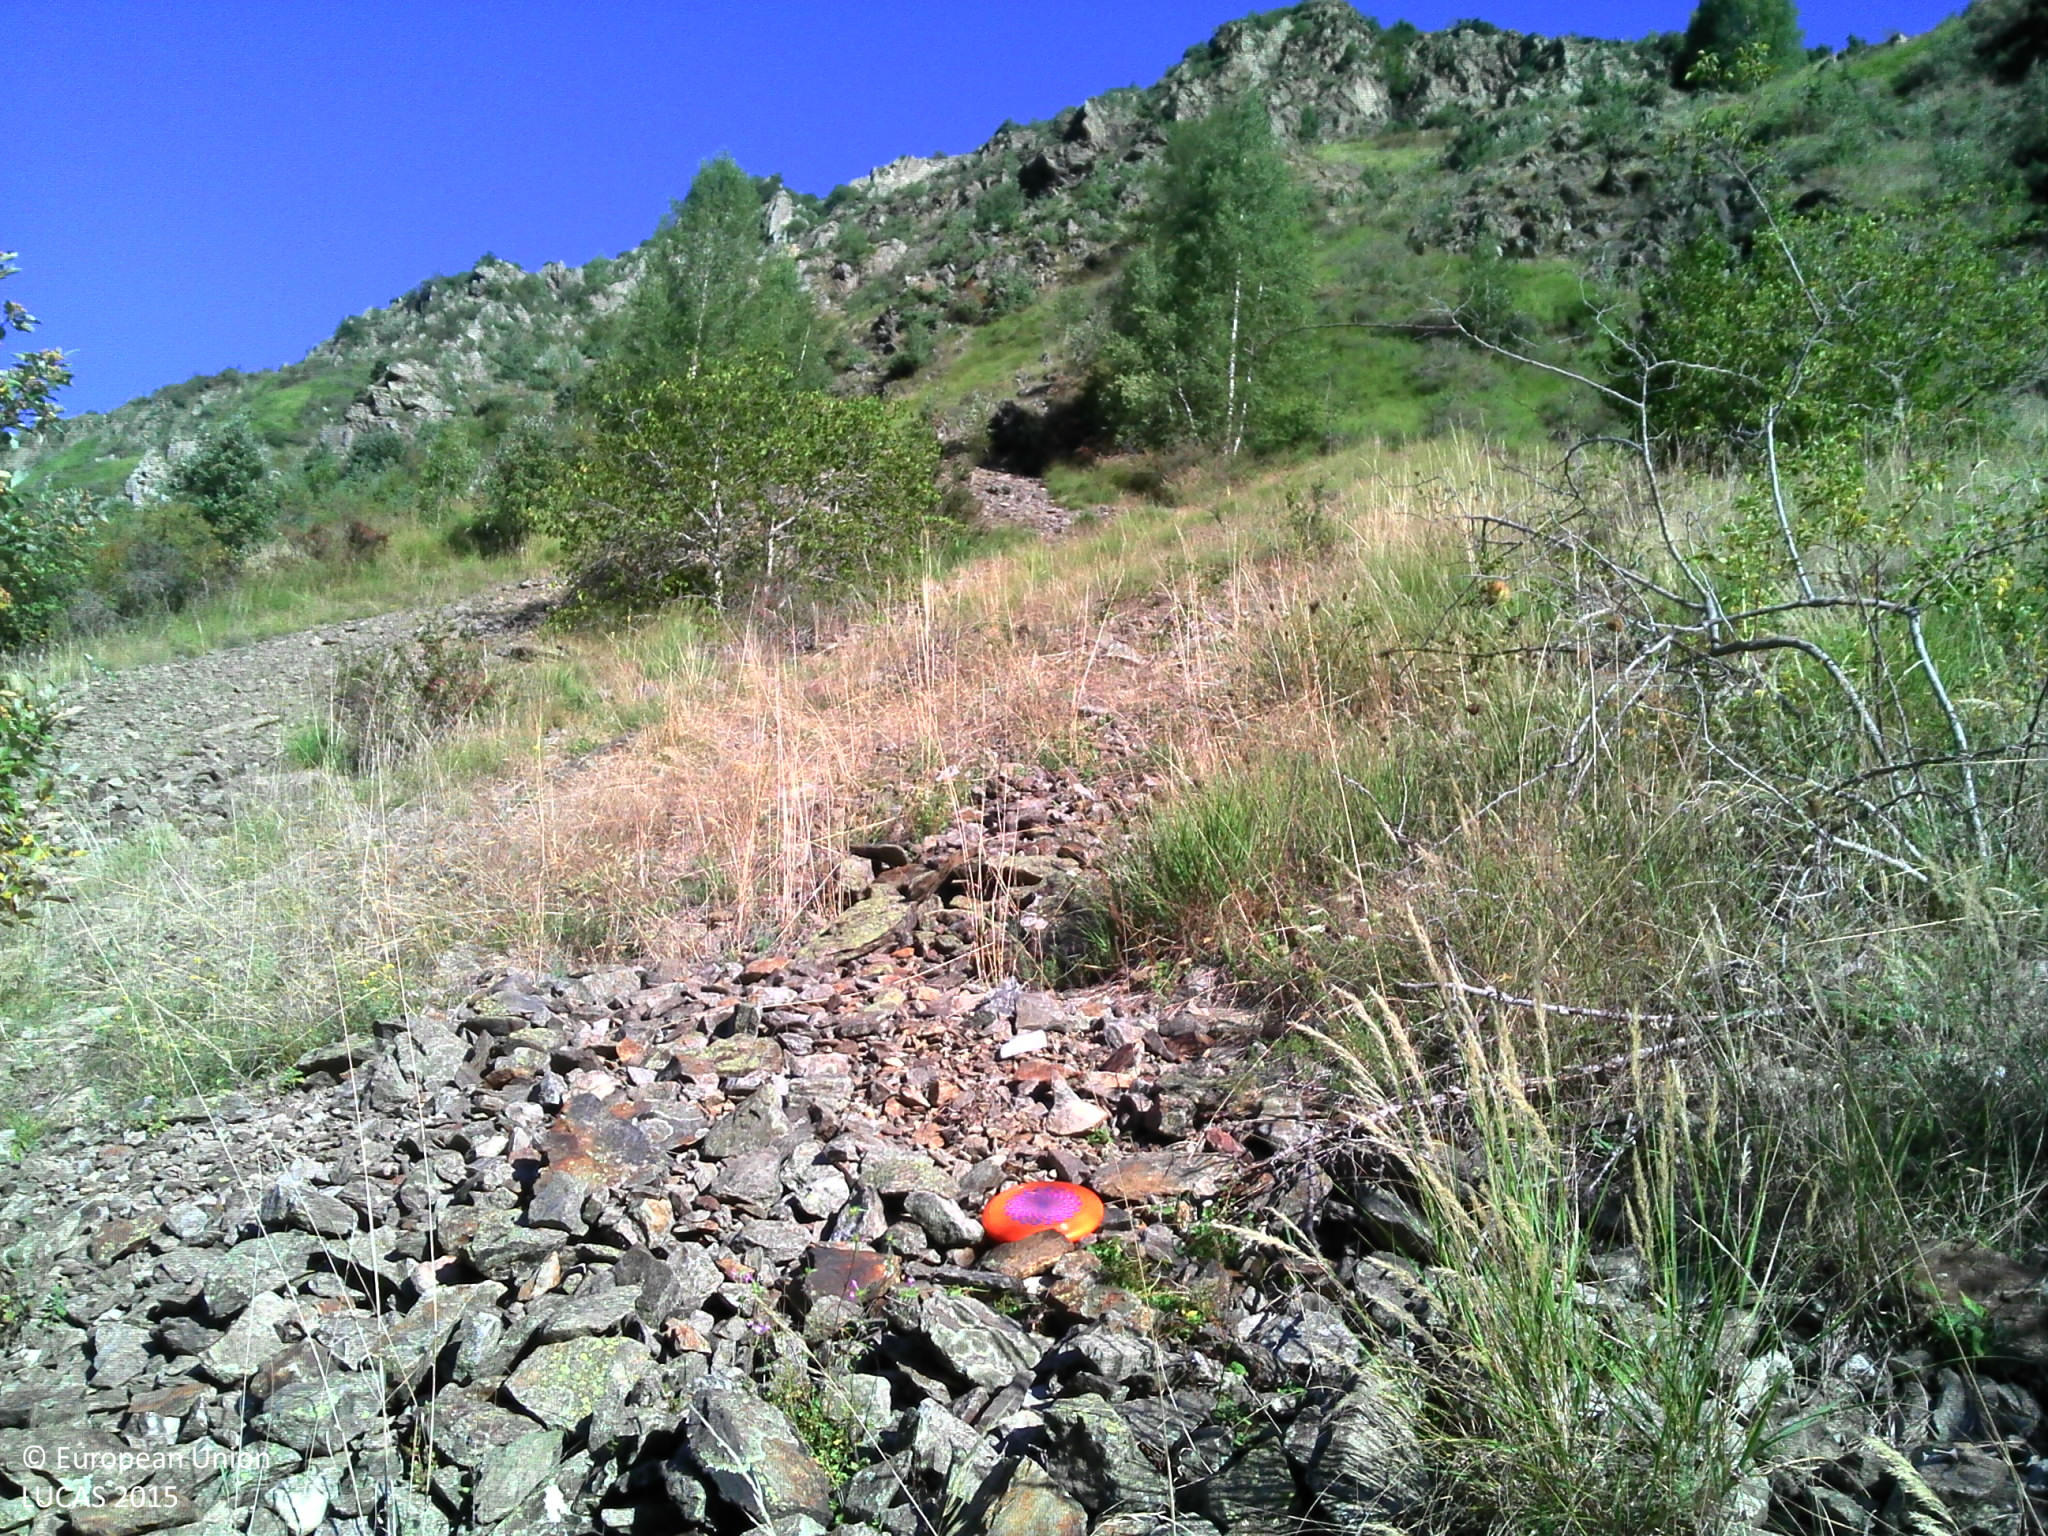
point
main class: Shrubland
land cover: Shrubland with sparse tree cover
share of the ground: > 75 %
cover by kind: consolidated bare surface 60 %, herbaceous plants 20 %, shrubs 15 %, broadleaved forest trees 5 %
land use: Semi-natural and natural areas not in use
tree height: > 5 m
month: August
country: FR
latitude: 44.8225
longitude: 6.1993
